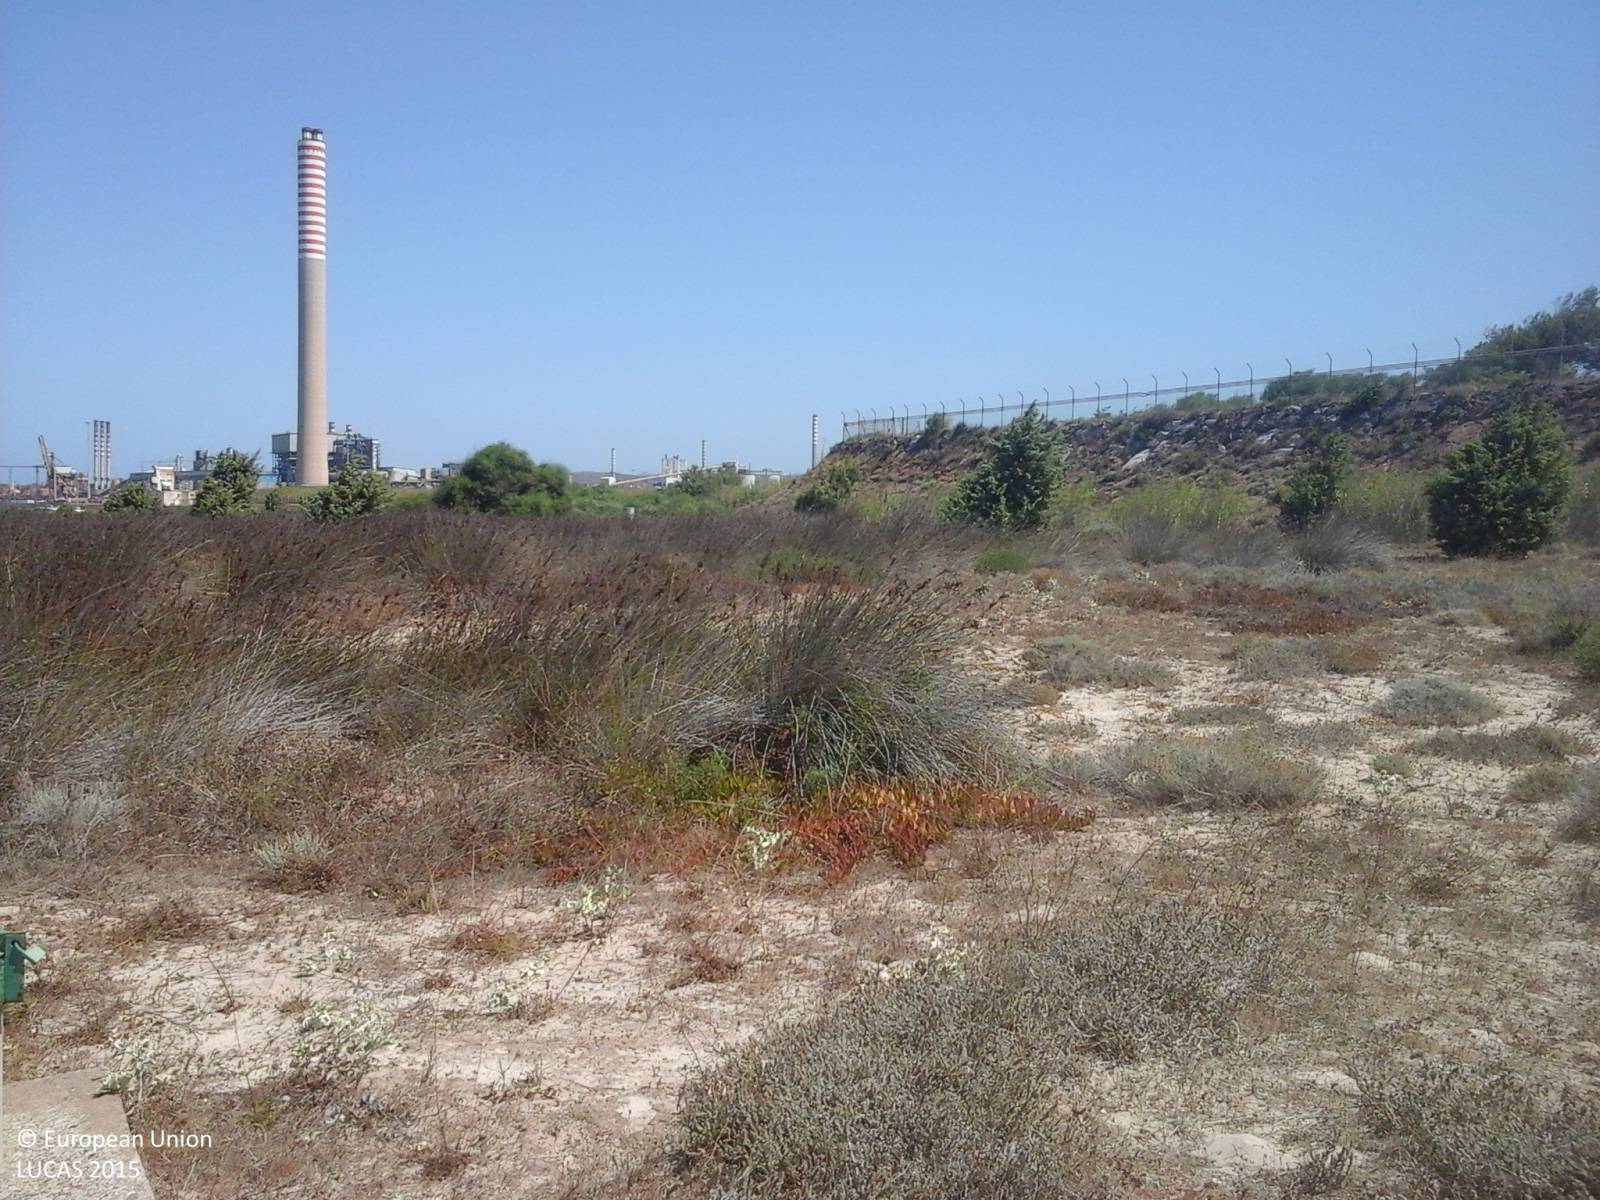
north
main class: Grassland
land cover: Grassland without tree/shrub cover
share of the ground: > 75 %
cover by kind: herbaceous plants 50 %, unconsolidated bare surface 45 %, consolidated bare surface 5 %
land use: Semi-natural and natural areas not in use
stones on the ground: < 10 %
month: July
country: IT
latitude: 39.1855
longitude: 8.4007
